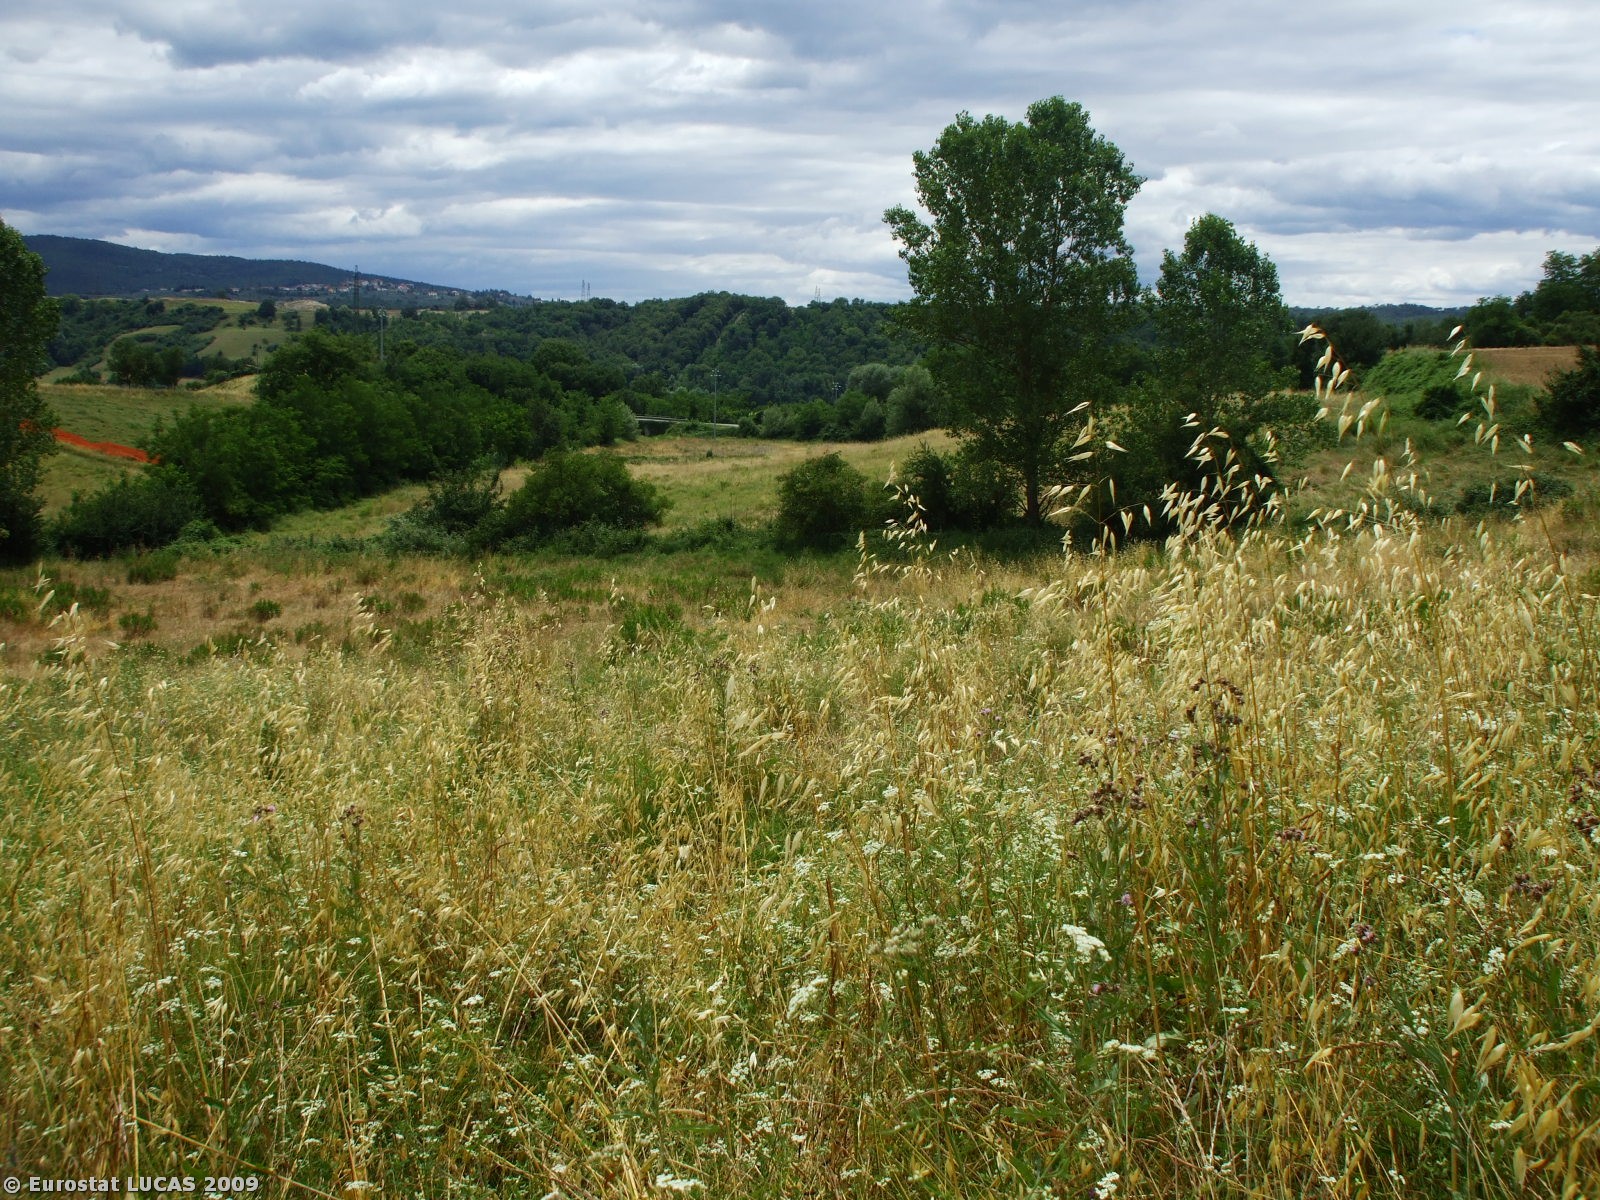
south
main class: Grassland
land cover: Grassland without tree/shrub cover
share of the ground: > 75 %
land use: Agriculture (excluding fallow land and kitchen gardens)
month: June
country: IT
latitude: 43.5067
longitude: 11.6899
